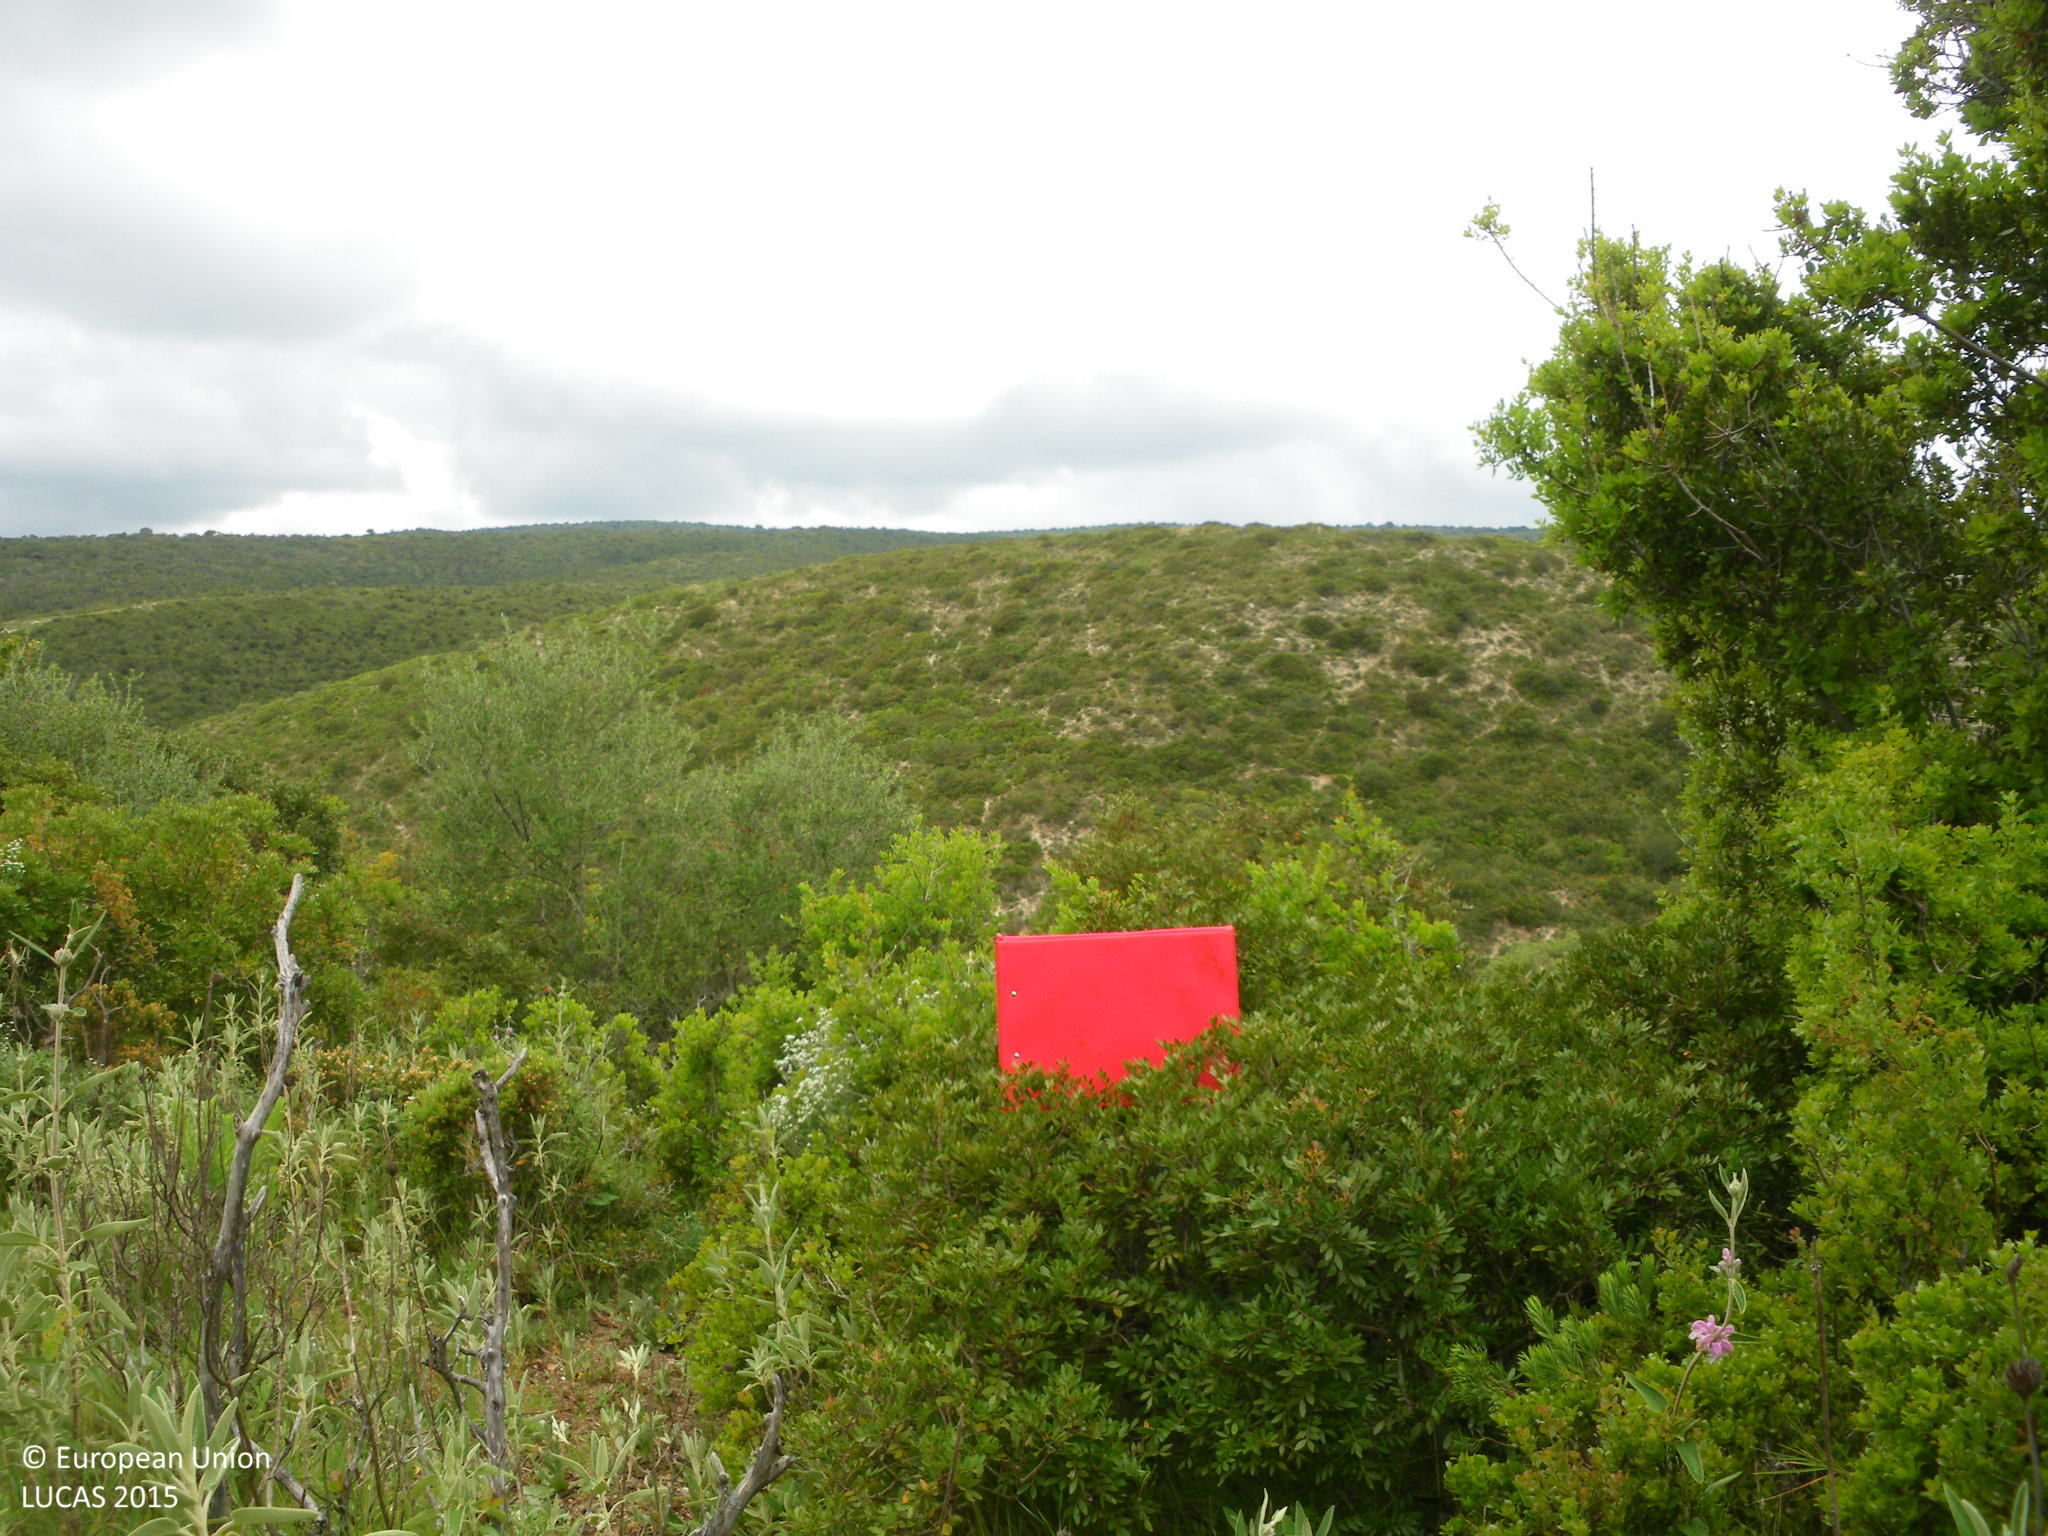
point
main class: Shrubland
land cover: Shrubland with sparse tree cover
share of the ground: > 75 %
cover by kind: shrubs 75 %, herbaceous plants 15 %, broadleaved forest trees 5 %, unconsolidated bare surface 5 %
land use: Agriculture (excluding fallow land and kitchen gardens)
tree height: < 5 m
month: April
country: ES
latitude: 36.5811
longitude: -5.7059
